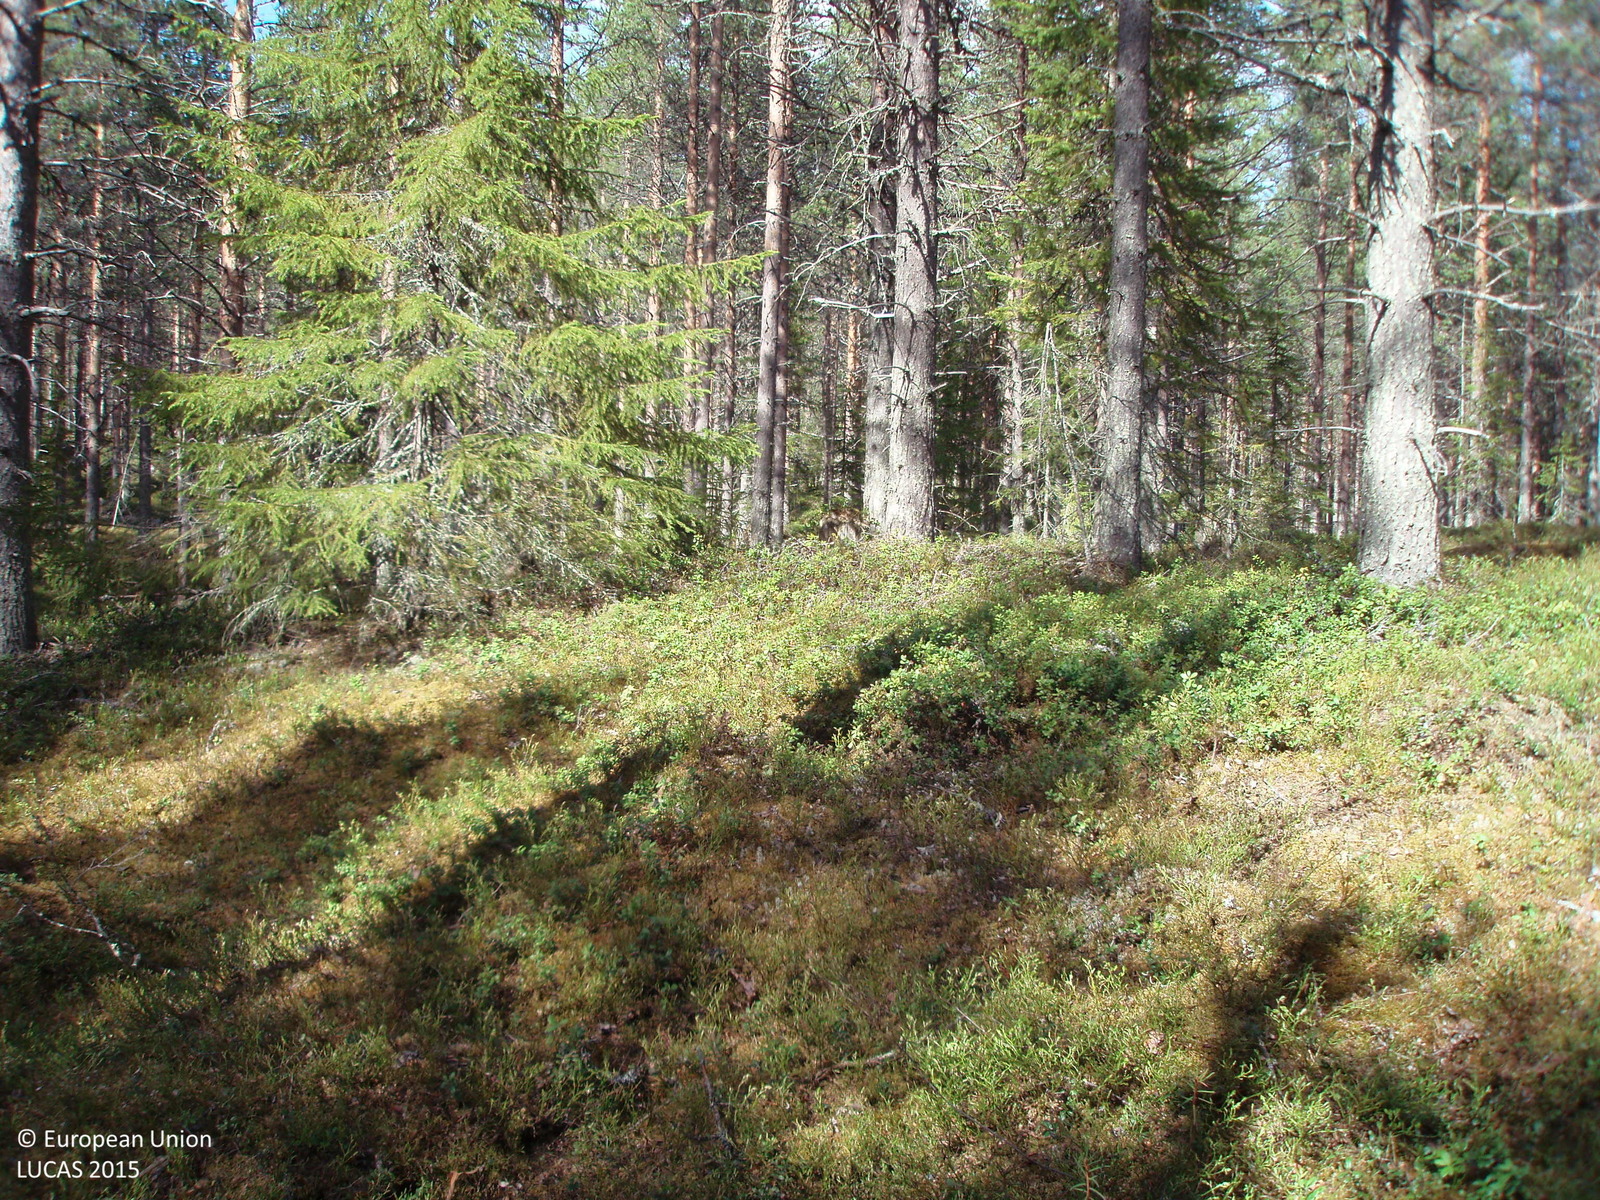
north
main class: Woodland
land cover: Pine dominated coniferous woodland
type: boreal forest
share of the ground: > 75 %
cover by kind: coniferous forest trees 75 %, shrubs 20 %, lichens and mosses 5 %
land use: Forestry
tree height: > 5 m
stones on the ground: < 10 %
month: June
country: FI
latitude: 66.7270
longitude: 26.9934
